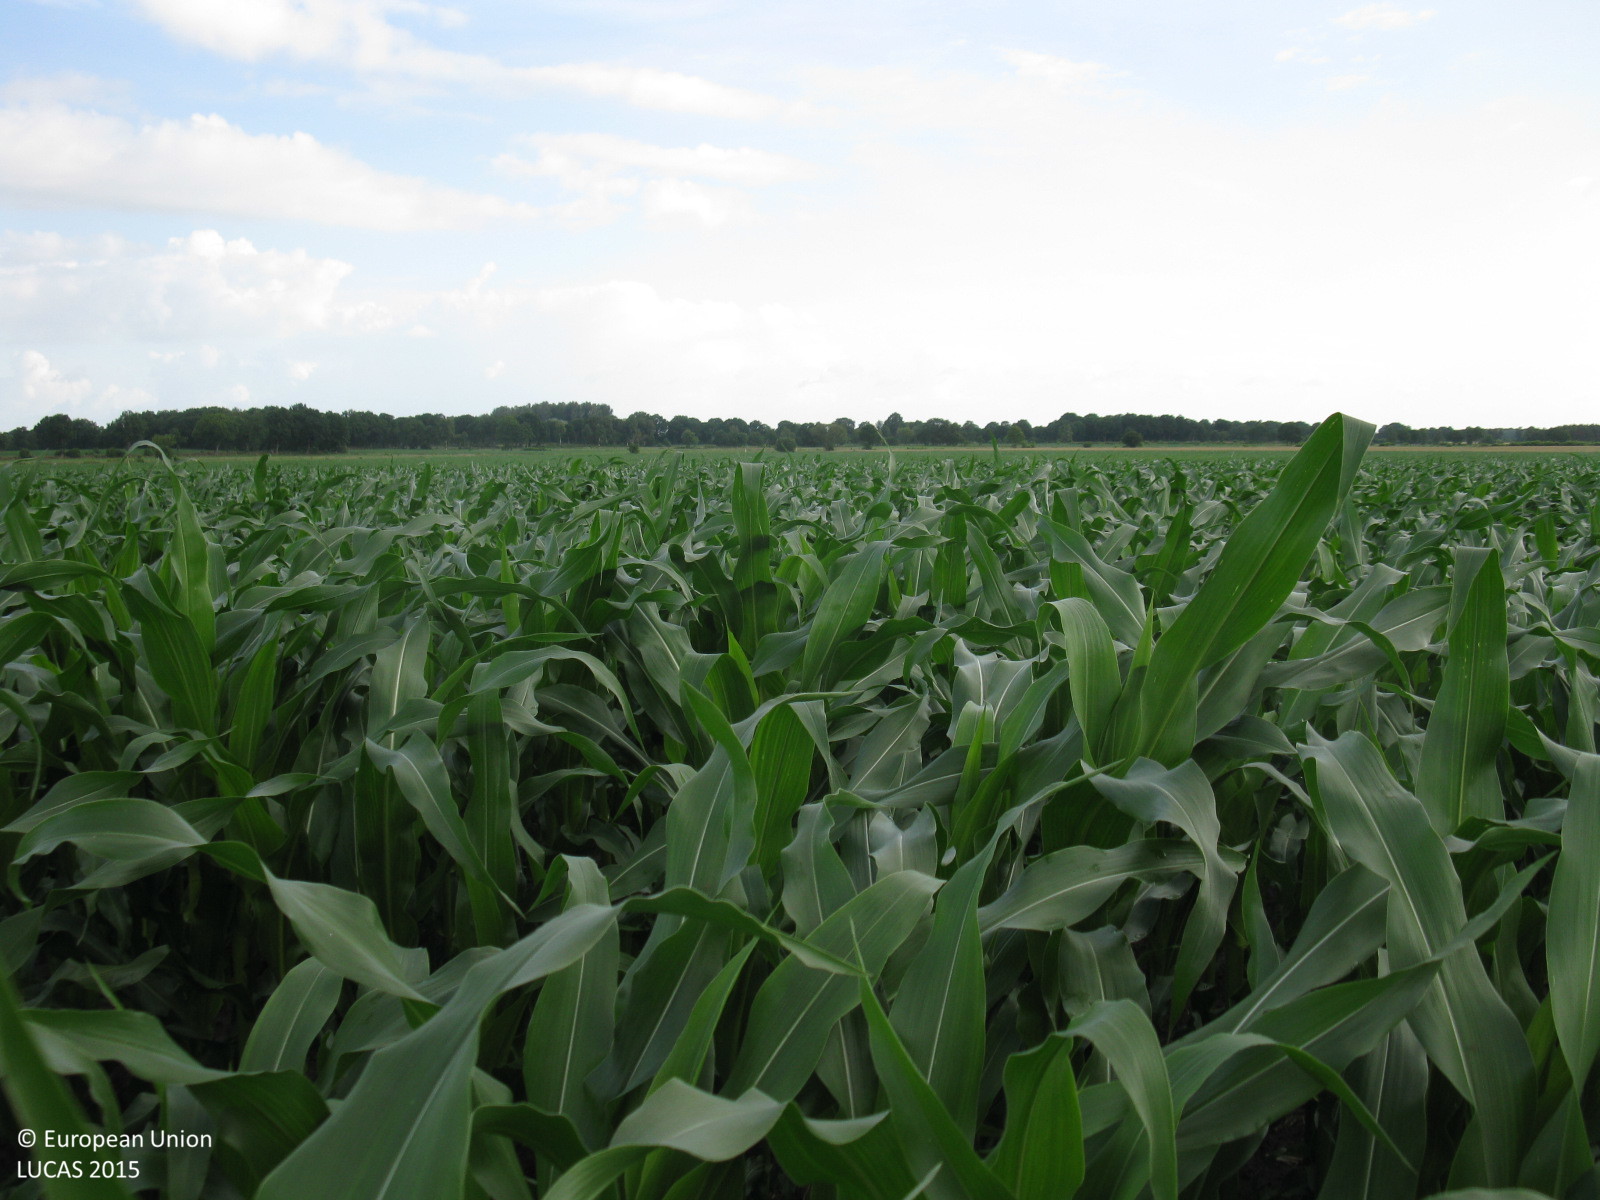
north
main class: Cropland
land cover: Maize
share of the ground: > 75 %
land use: Agriculture (excluding fallow land and kitchen gardens)
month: July
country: DE
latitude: 53.4193
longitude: 7.8791
